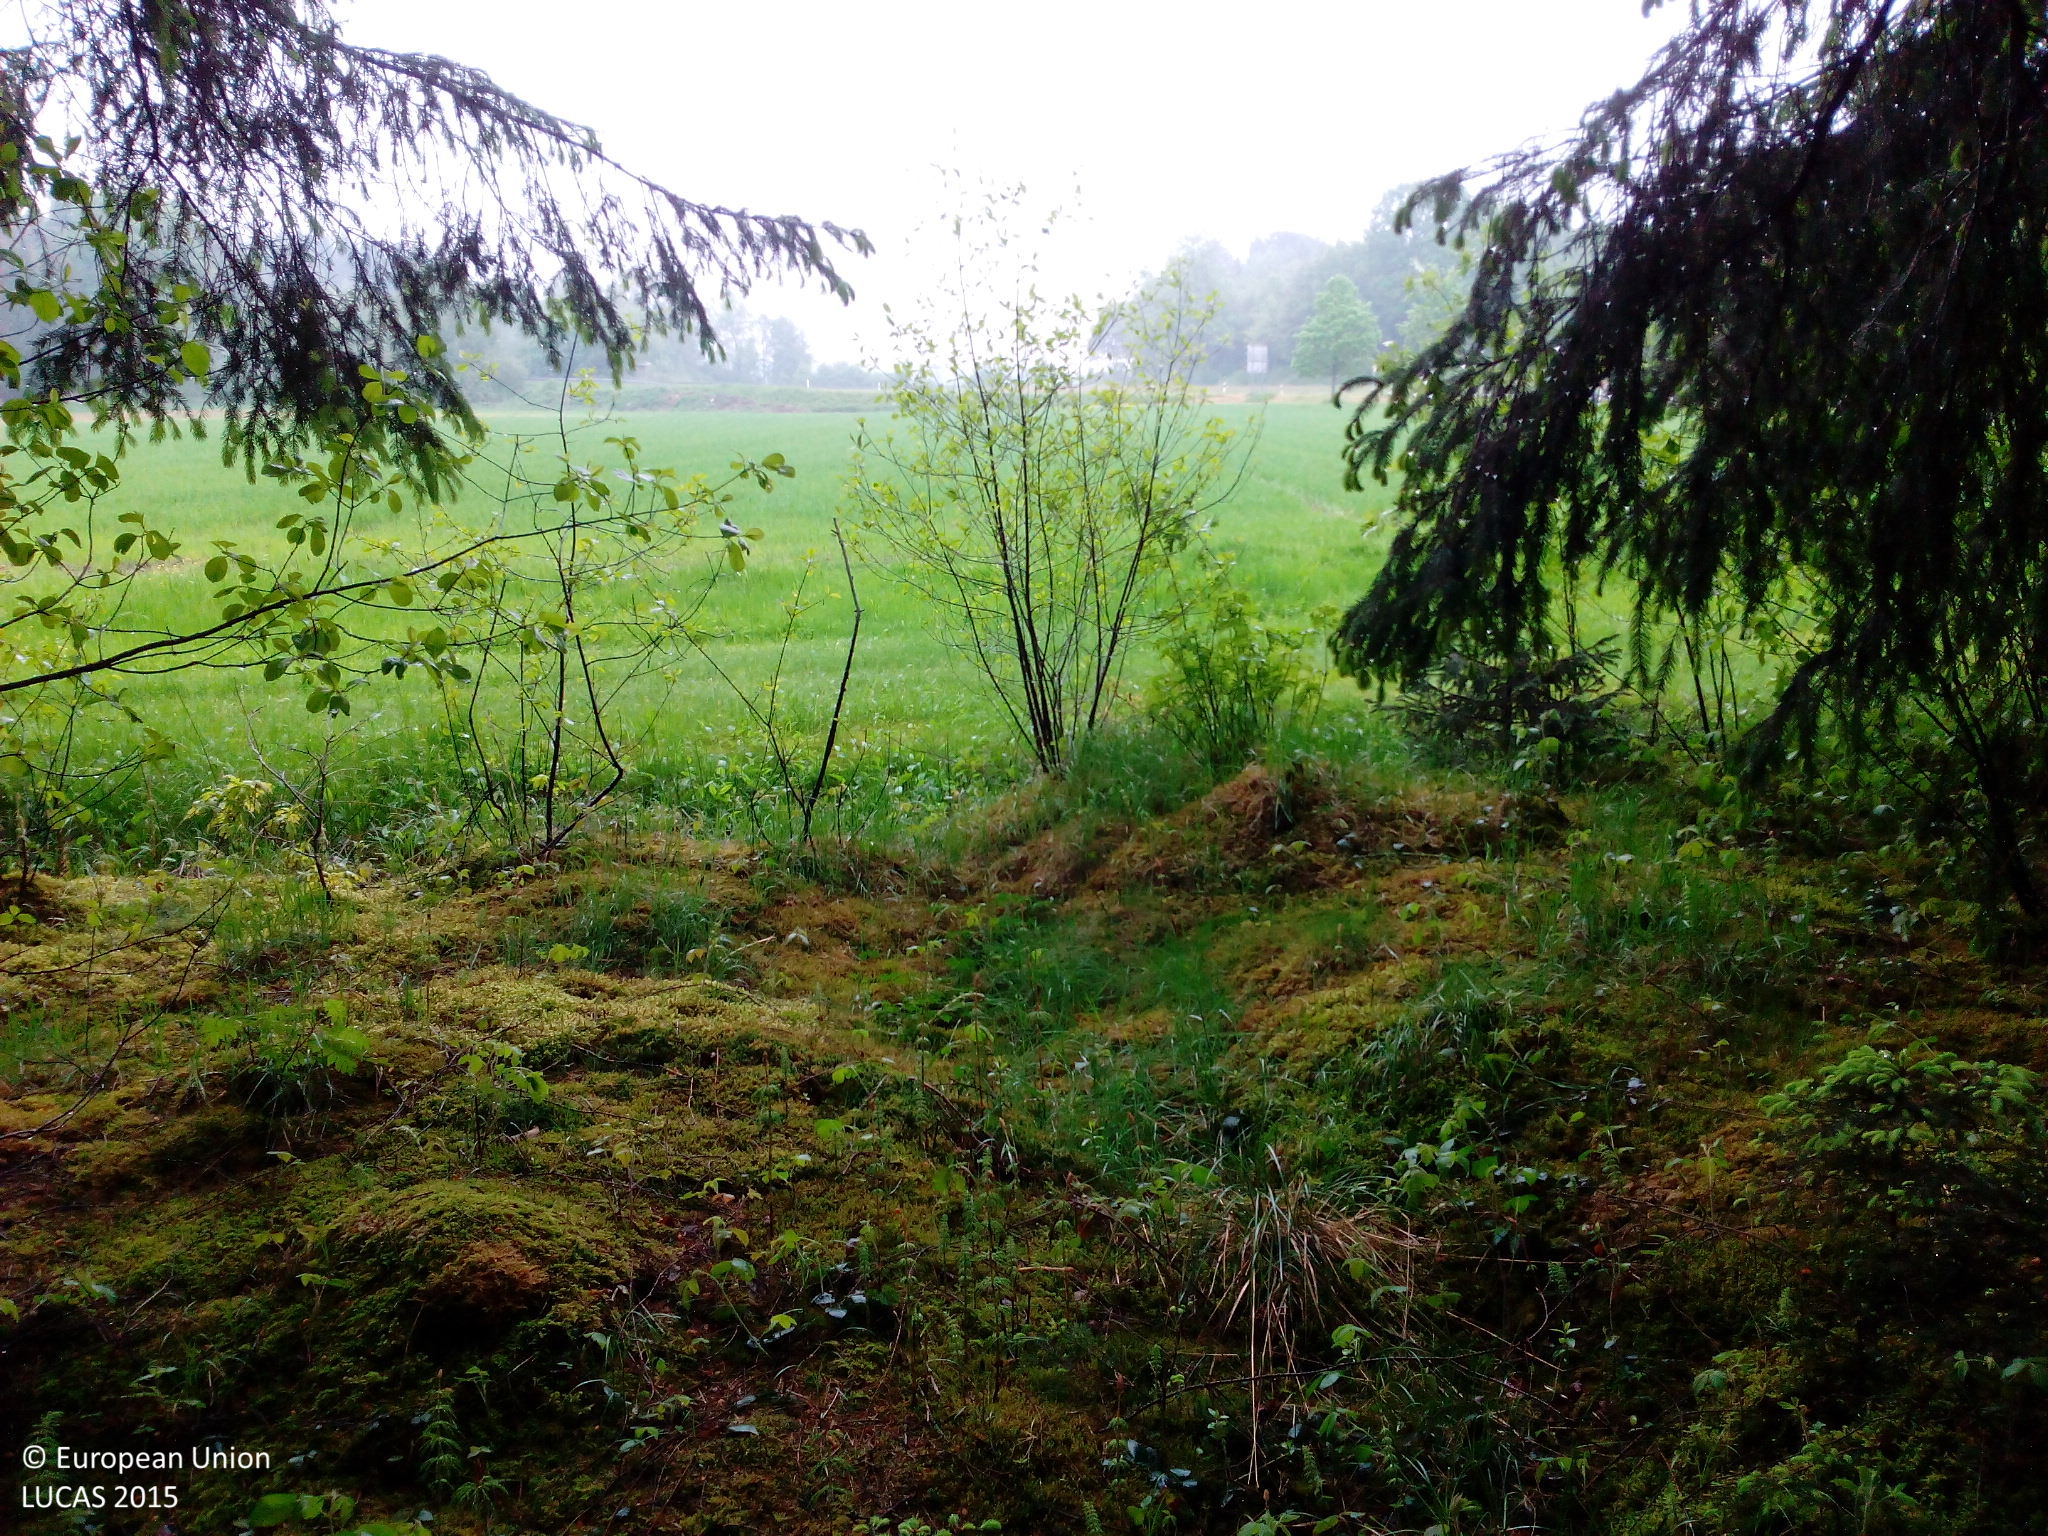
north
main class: Woodland
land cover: Spruce dominated coniferous woodland
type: hemiboreal forest and nemoral coniferous forest and mixed broadleaved-coniferous forest
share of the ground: > 75 %
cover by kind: coniferous forest trees 100 %
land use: Forestry
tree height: > 5 m
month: May
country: DE
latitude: 48.1151
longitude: 9.6913
